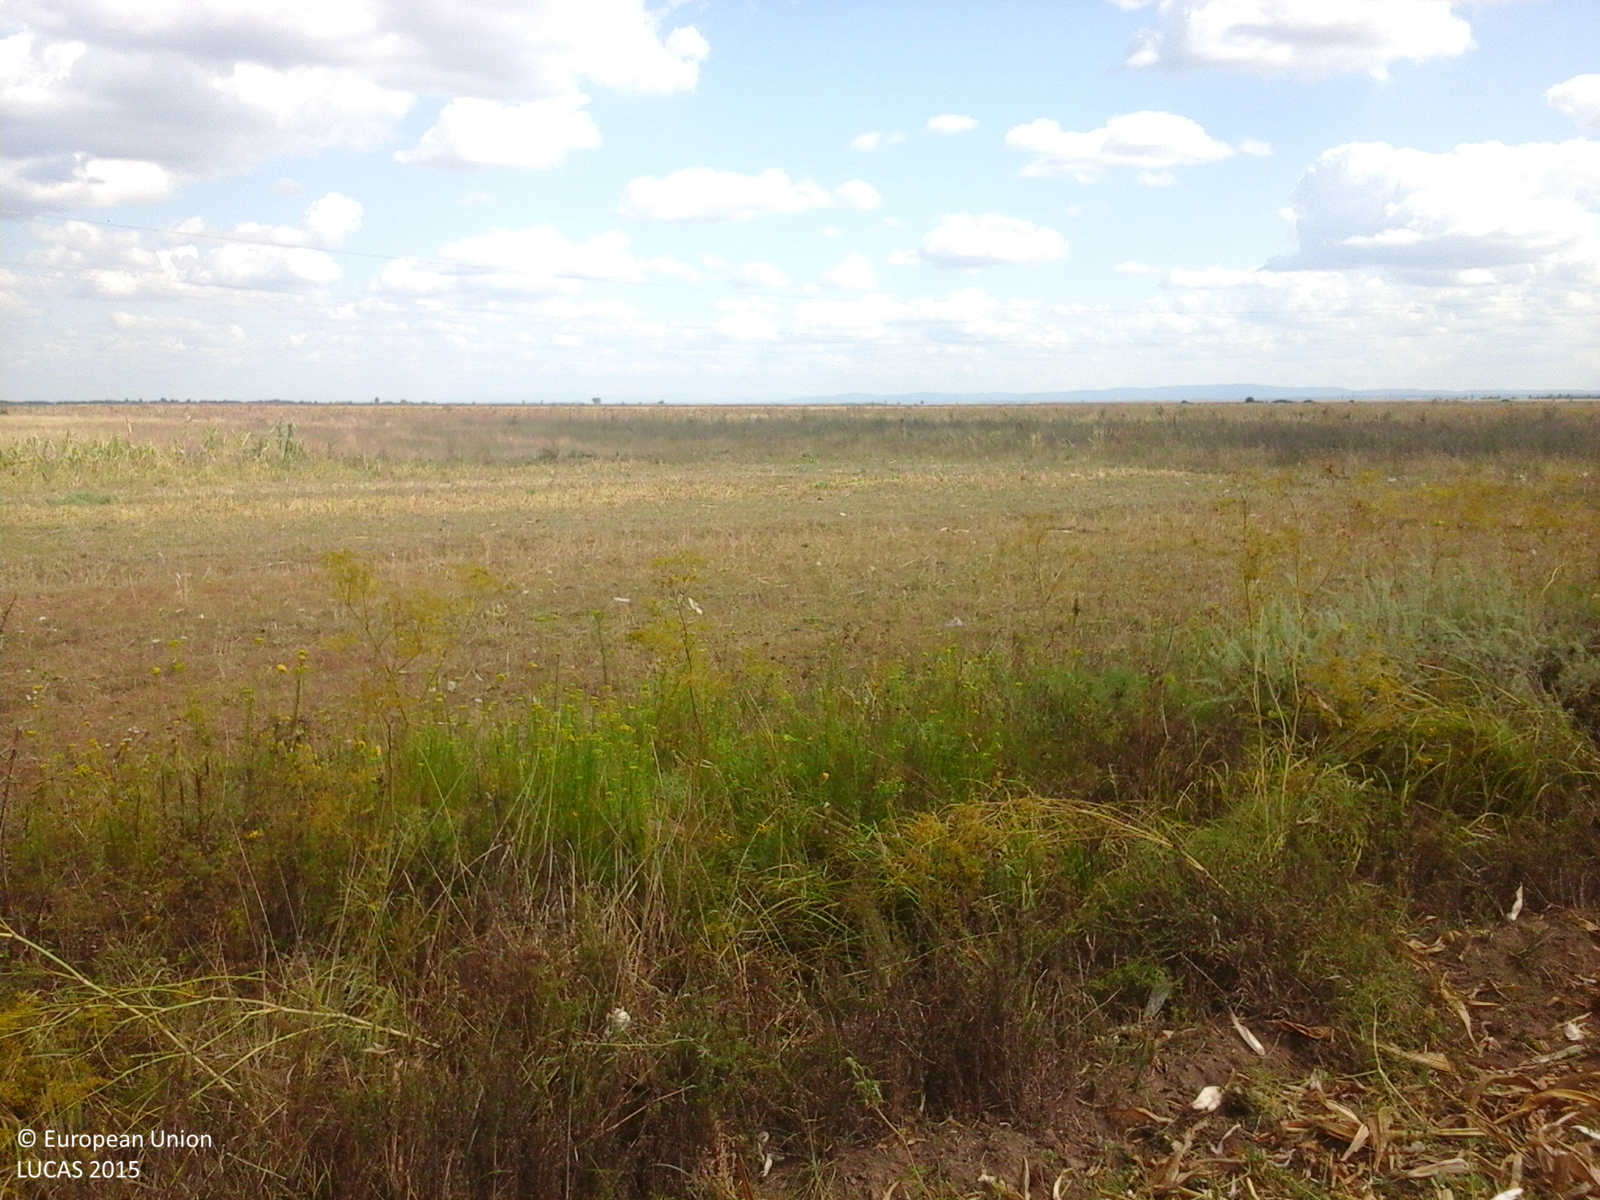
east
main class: Cropland
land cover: Maize
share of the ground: 10 - 25 %
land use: Agriculture (excluding fallow land and kitchen gardens)
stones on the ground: < 10 %
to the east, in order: Maize; Ditches and canals; Grassland without tree/shrub cover; Ditches and canals; Spontaneously vegetated surfaces; Electric lines; Spontaneously vegetated surfaces
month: September
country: RO
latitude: 47.5499
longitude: 22.6160
